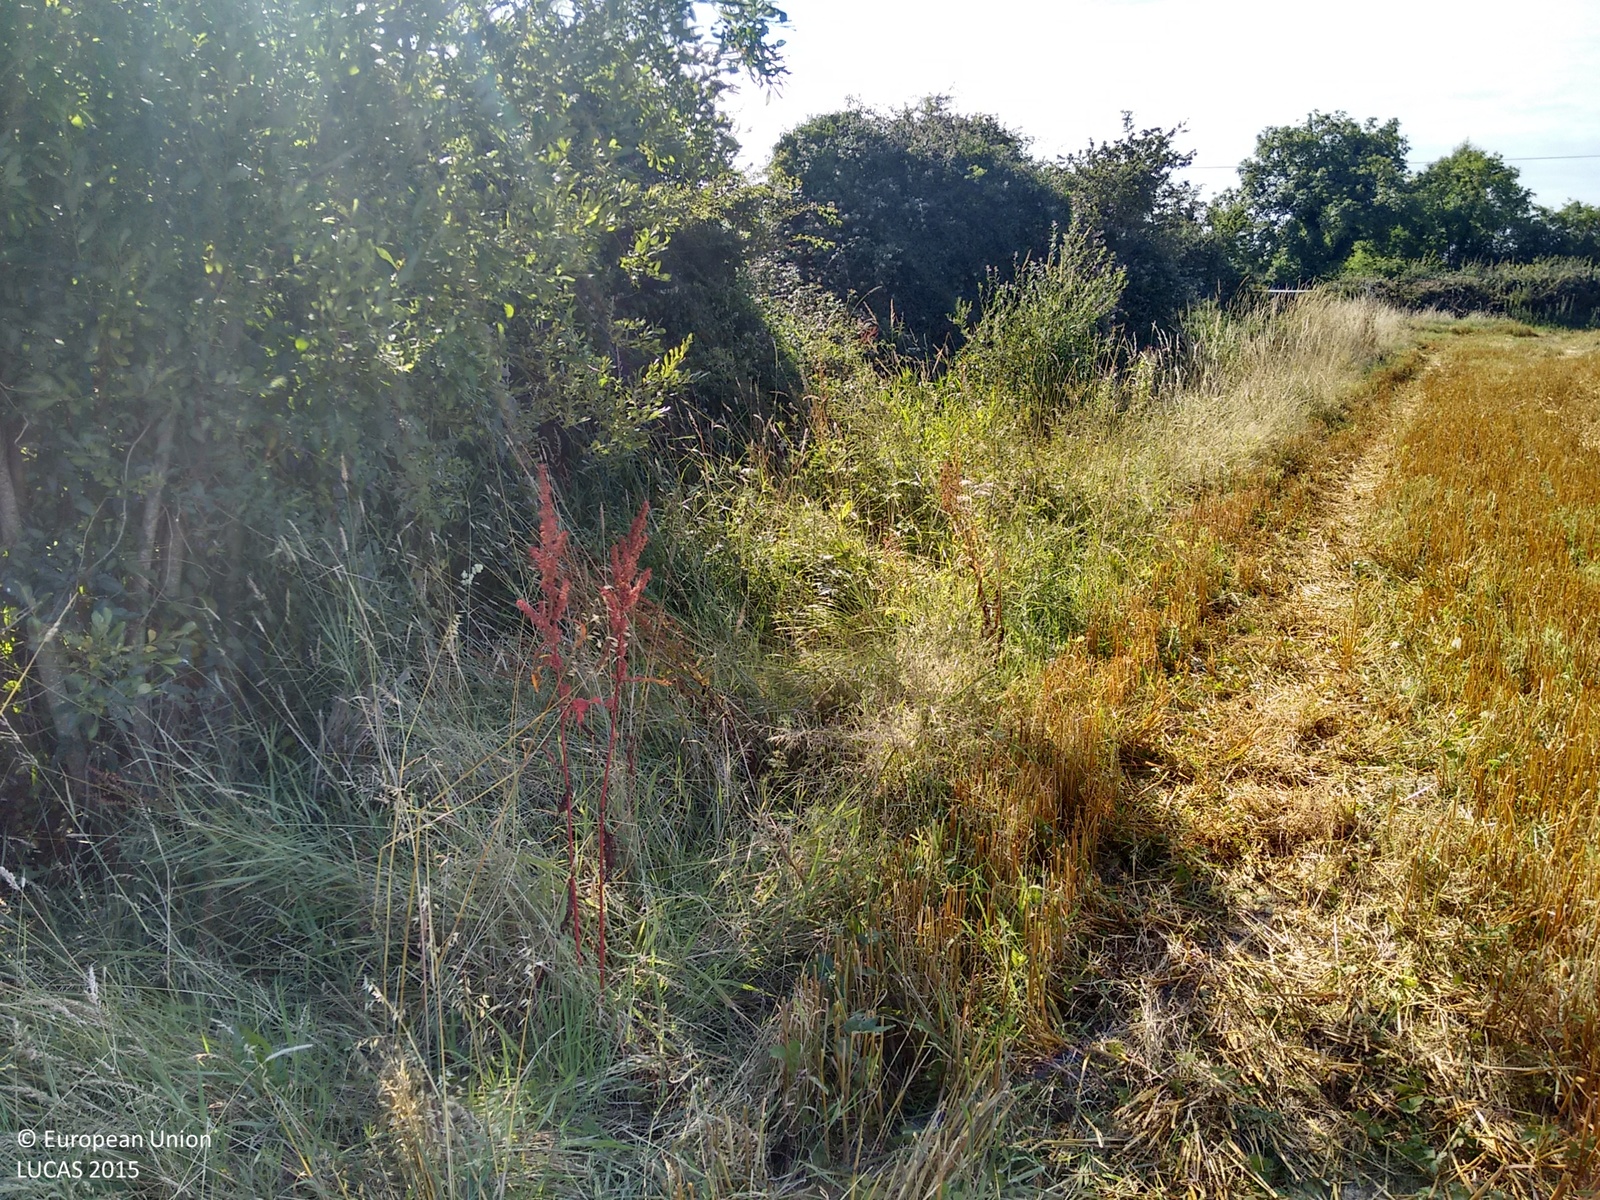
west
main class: Cropland
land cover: Oats
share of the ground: > 75 %
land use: Agriculture (excluding fallow land and kitchen gardens)
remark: Harvested field
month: August
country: IE
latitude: 53.8509
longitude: -6.2785
